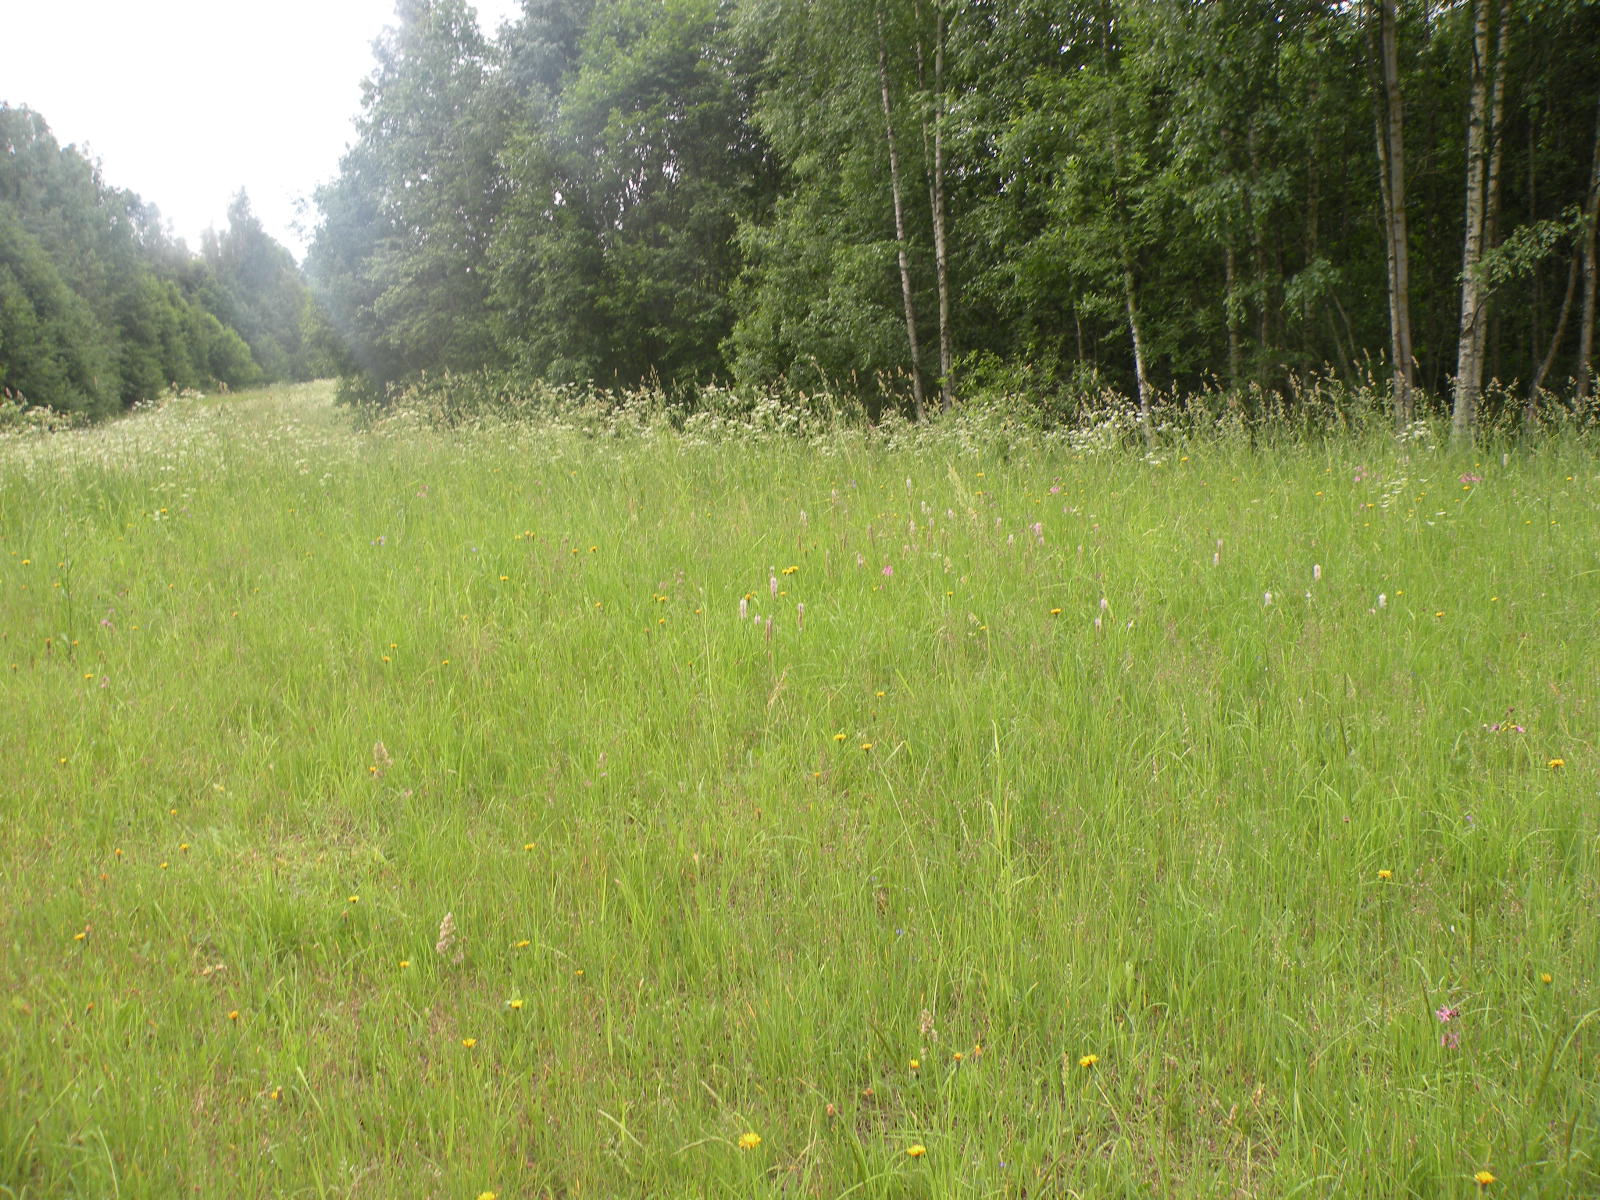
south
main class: Grassland
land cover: Grassland without tree/shrub cover
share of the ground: > 75 %
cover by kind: herbaceous plants 100 %
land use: Agriculture (excluding fallow land and kitchen gardens)
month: June
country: LV
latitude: 55.9922
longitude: 27.0481
